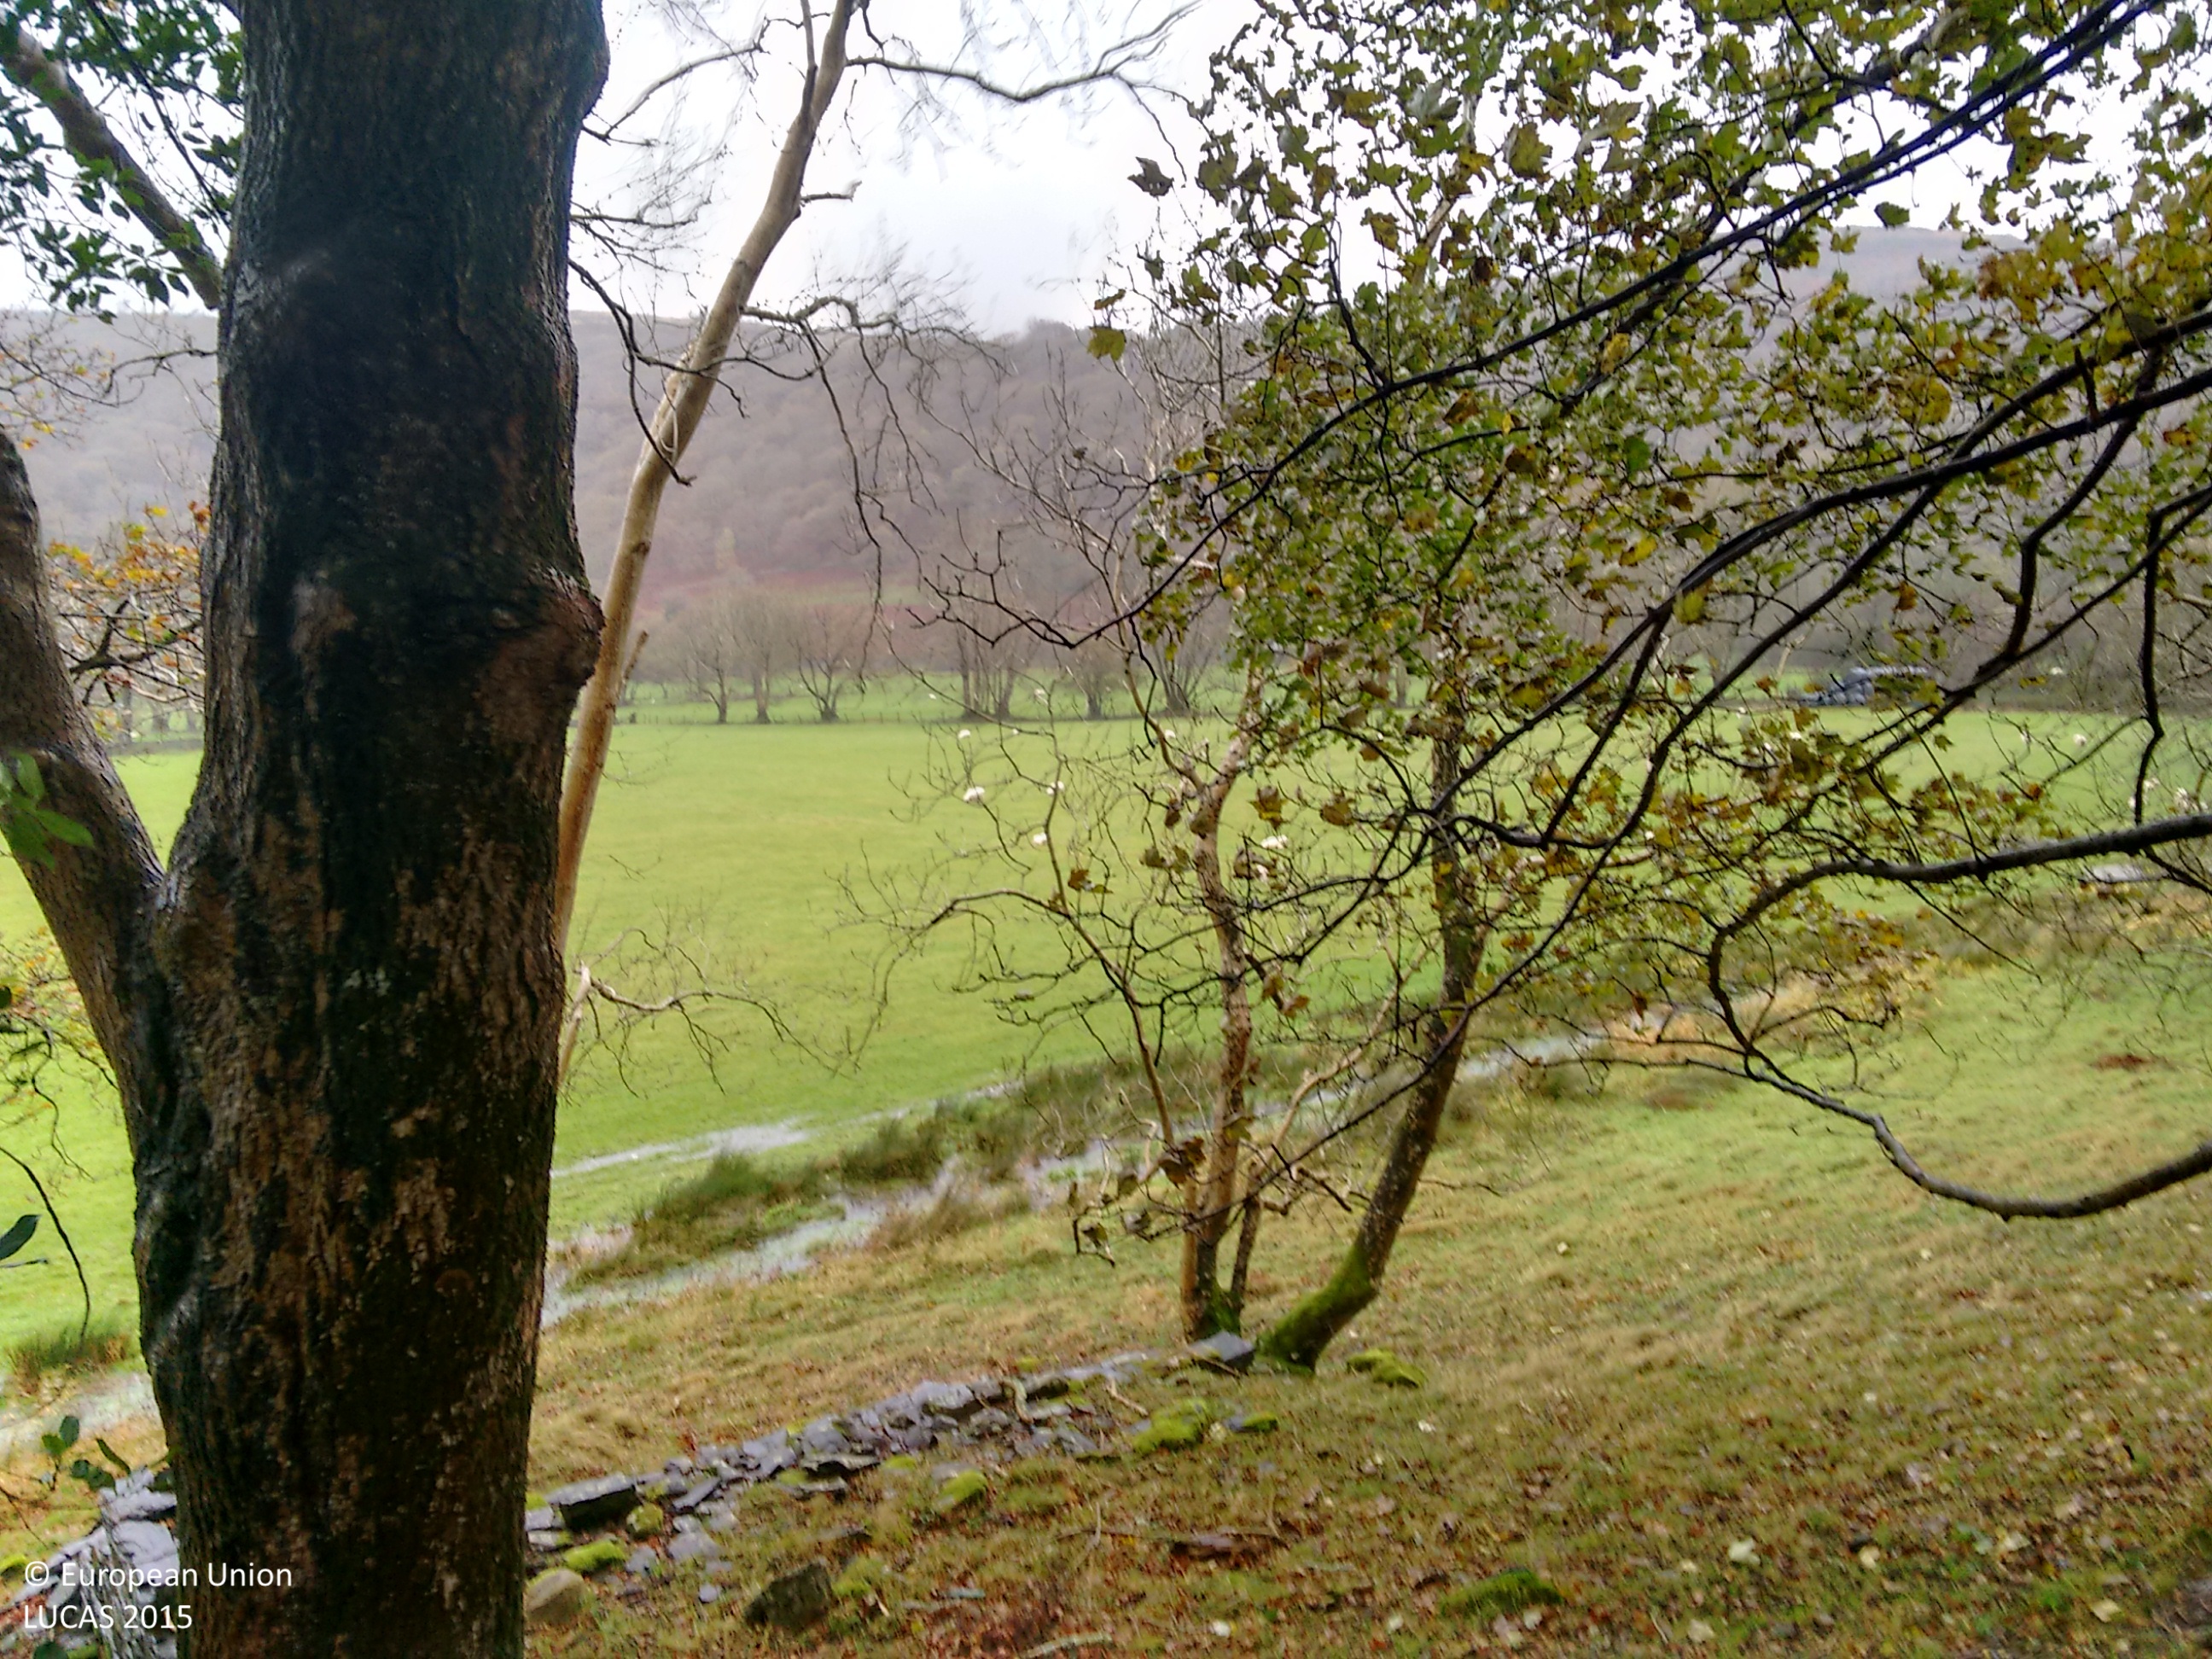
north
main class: Grassland
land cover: Grassland without tree/shrub cover
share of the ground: > 75 %
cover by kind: herbaceous plants 100 %
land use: Agriculture (excluding fallow land and kitchen gardens)
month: November
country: GB
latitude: 52.9507
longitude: -3.9803
